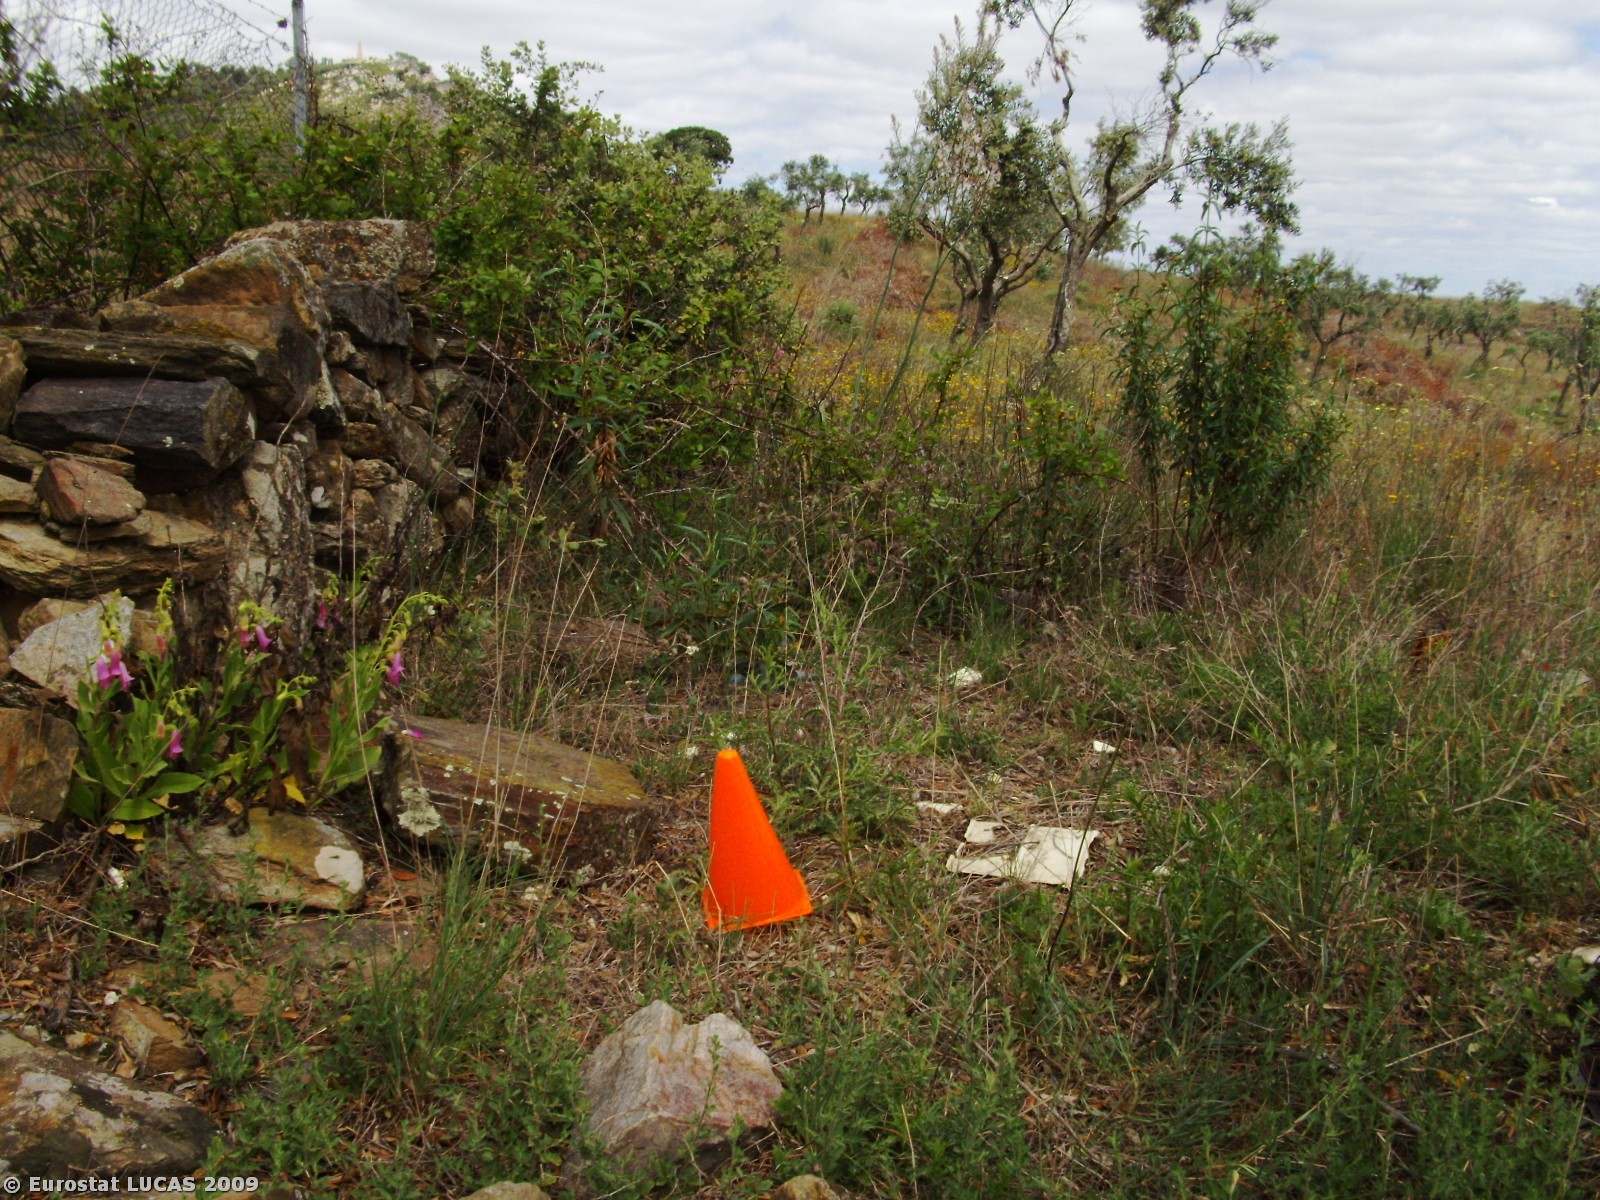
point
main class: Cropland
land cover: Olive groves
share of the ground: 25 - 50 %
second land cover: Spontaneously vegetated surfaces
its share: 50 - 75 %
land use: Agriculture (excluding fallow land and kitchen gardens)
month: April
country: PT
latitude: 39.7948
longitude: -7.4636
